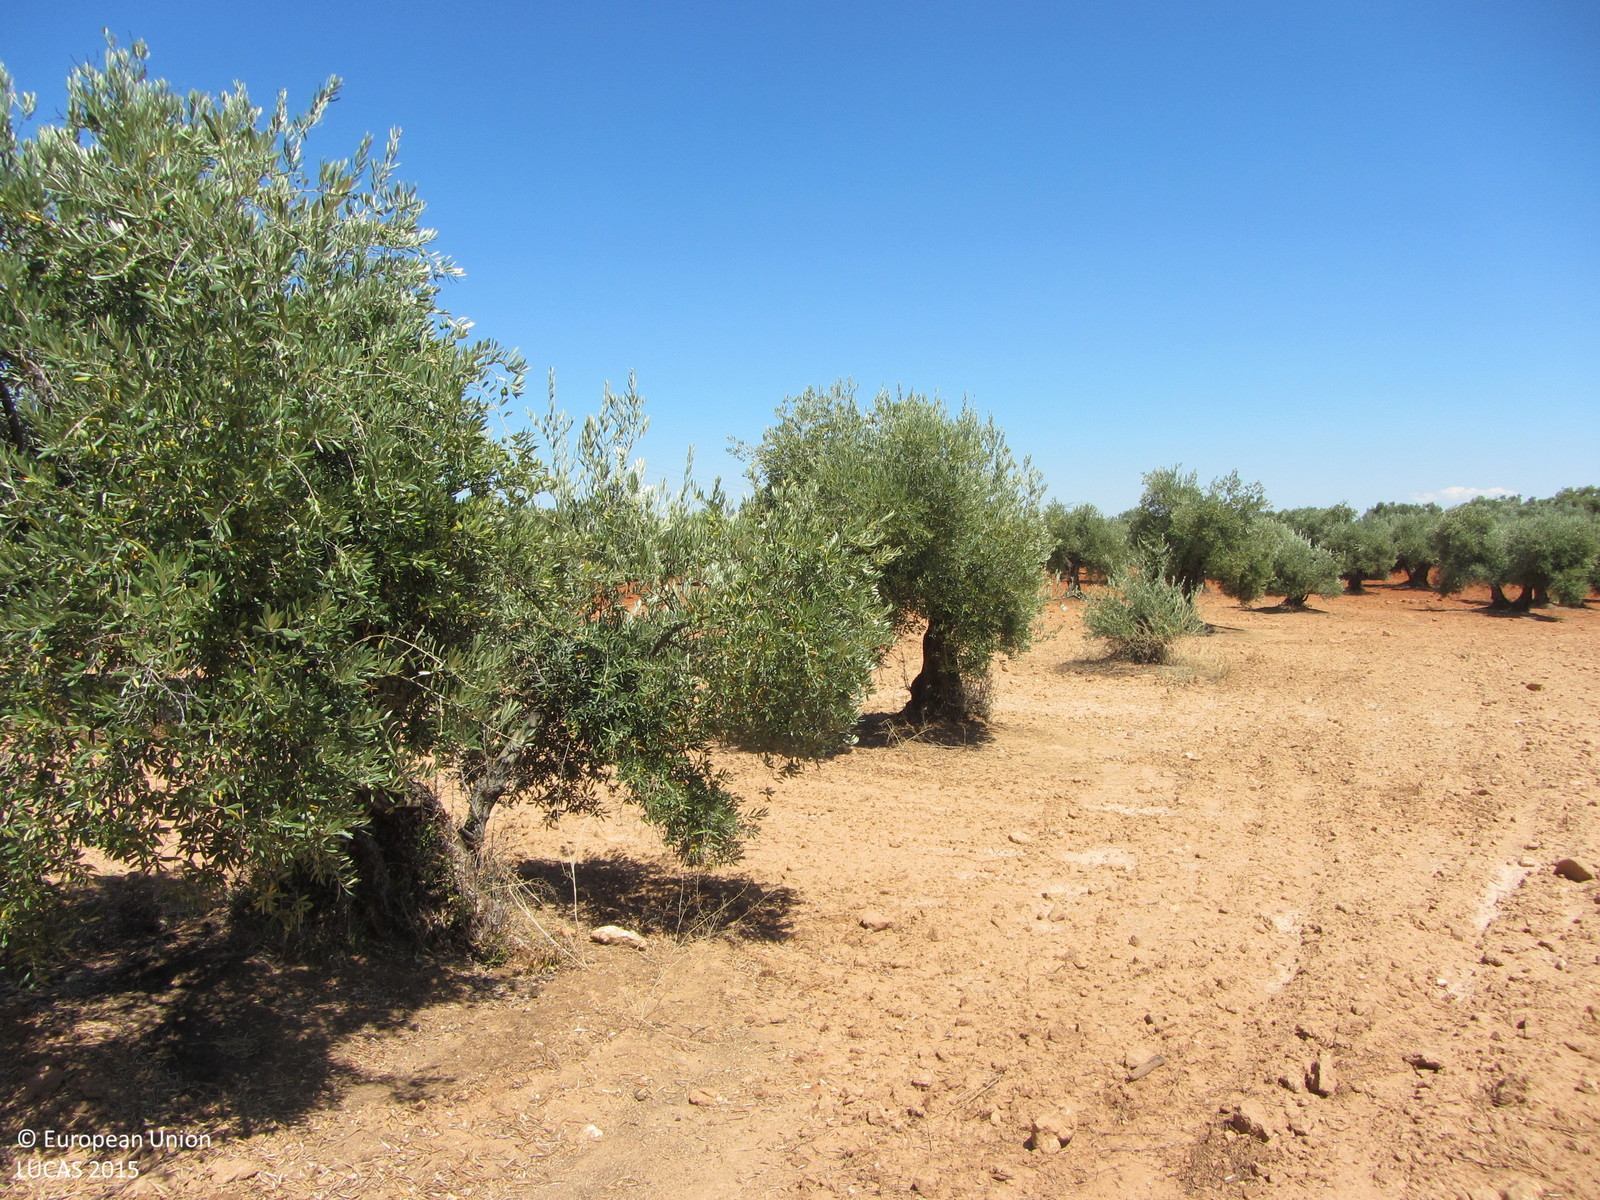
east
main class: Cropland
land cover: Olive groves
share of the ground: 25 - 50 %
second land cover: Other bare soil
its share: > 75 %
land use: Agriculture (excluding fallow land and kitchen gardens)
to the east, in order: Olive groves; Other bare soil; Tracks; Olive groves; Dry stone walls; Olive groves; Other structural elements; Olive groves; Other structural elements; Olive groves
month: July
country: ES
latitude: 38.0688
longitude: -4.2244
